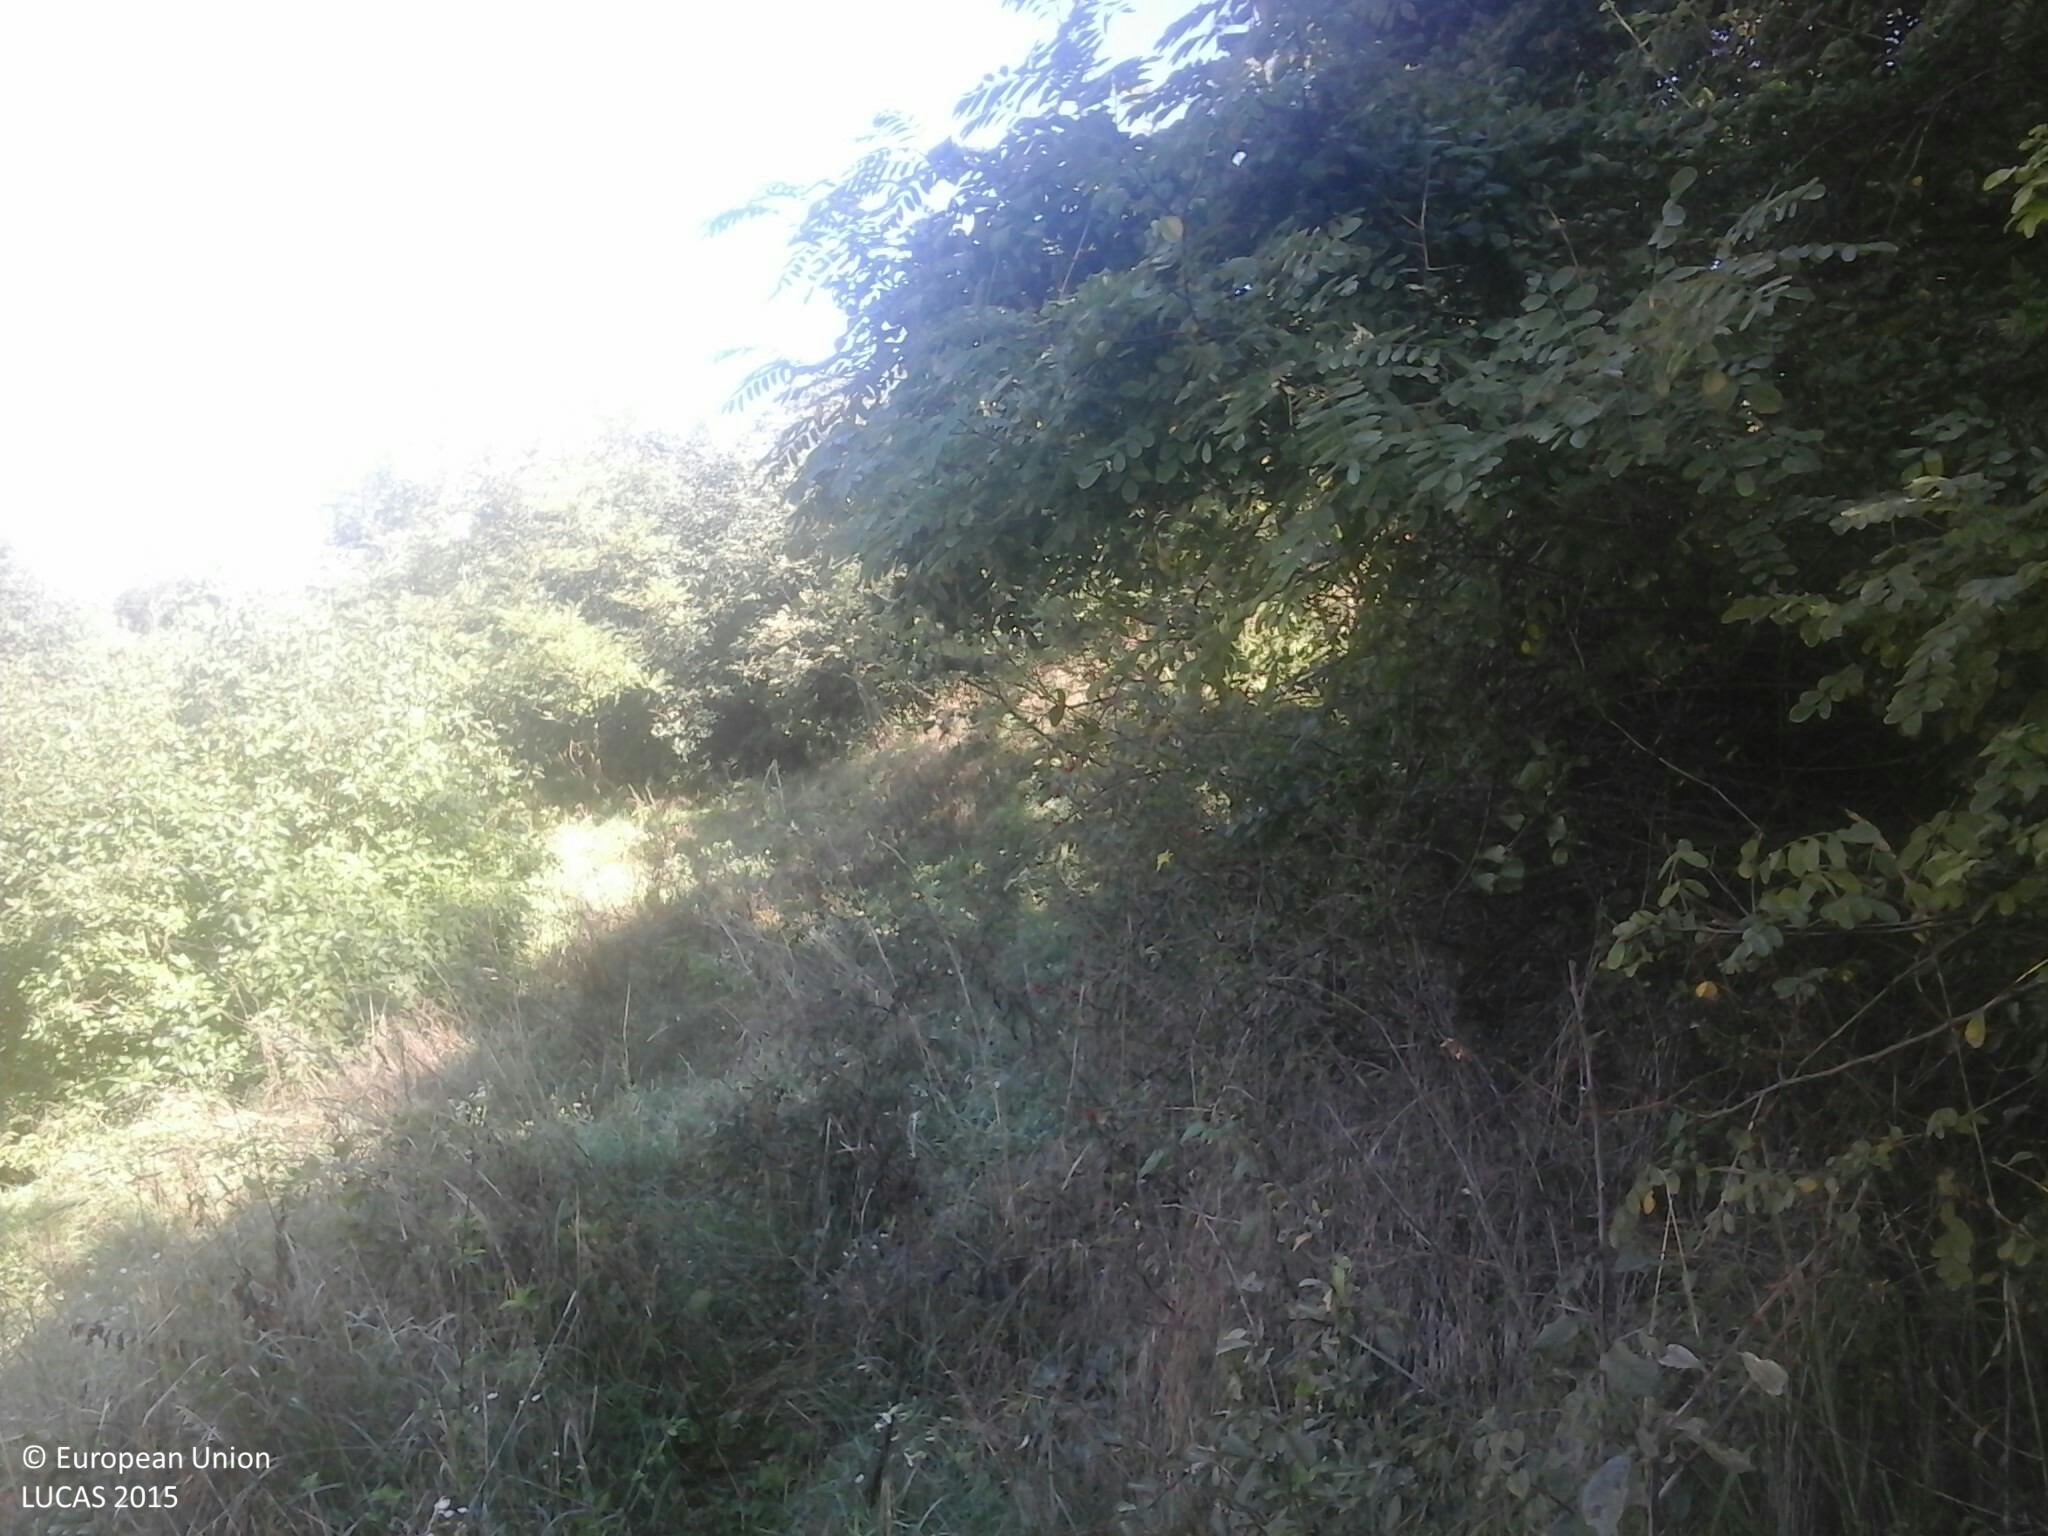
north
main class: Shrubland
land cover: Shrubland with sparse tree cover
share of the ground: > 75 %
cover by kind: shrubs 90 %, broadleaved forest trees 5 %, herbaceous plants 5 %
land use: Fallow land
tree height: > 5 m
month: September
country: HU
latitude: 48.0403
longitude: 19.9939
